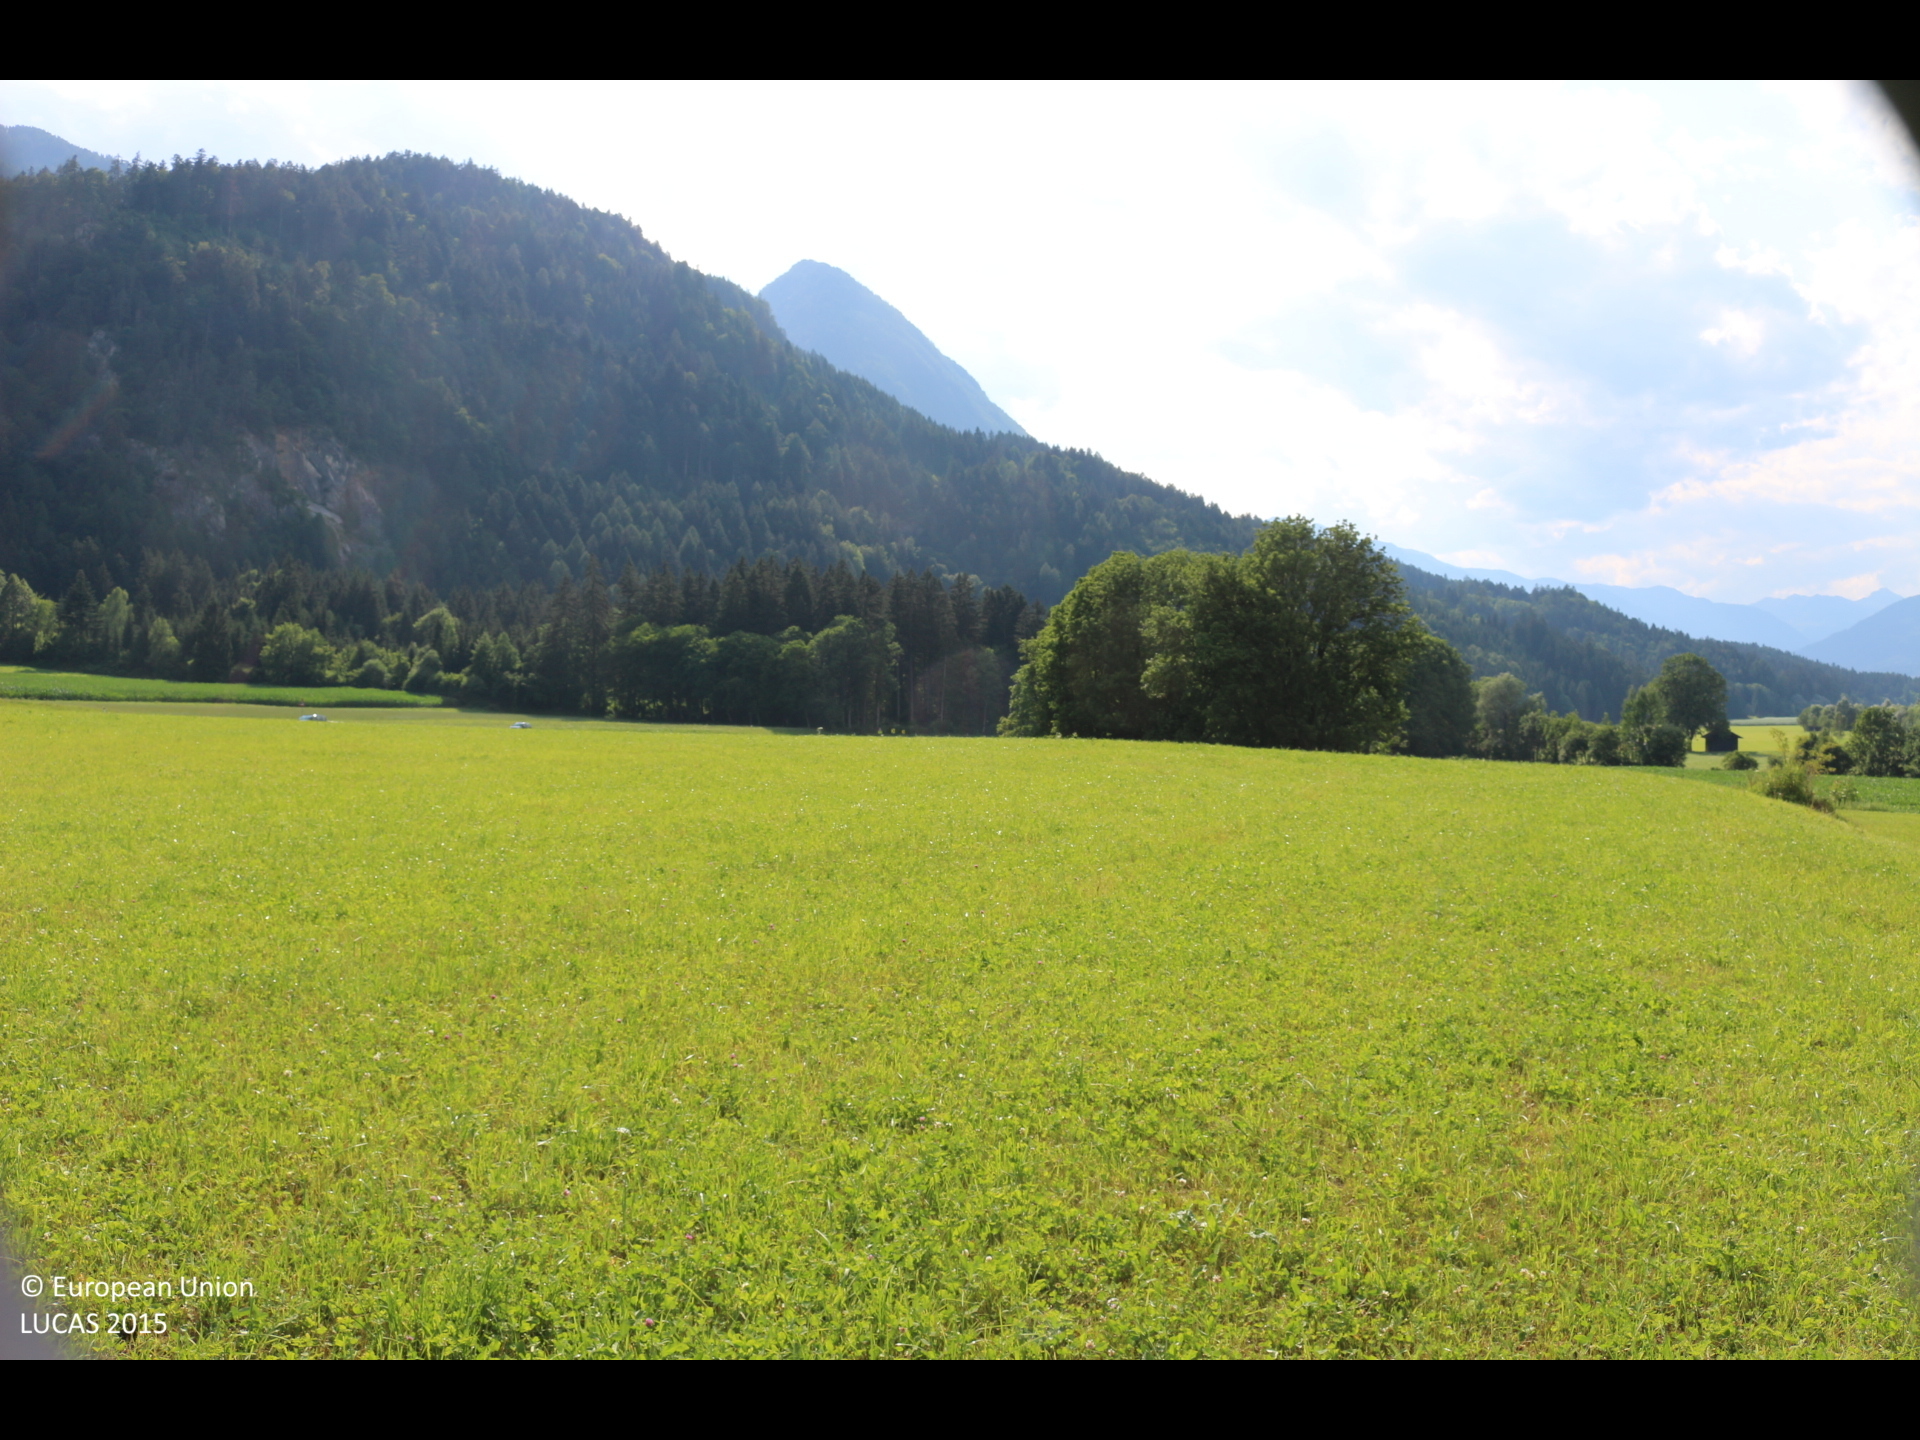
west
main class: Grassland
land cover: Grassland without tree/shrub cover
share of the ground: > 75 %
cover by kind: herbaceous plants 100 %
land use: Agriculture (excluding fallow land and kitchen gardens)
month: July
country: AT
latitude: 46.8001
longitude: 12.8407
